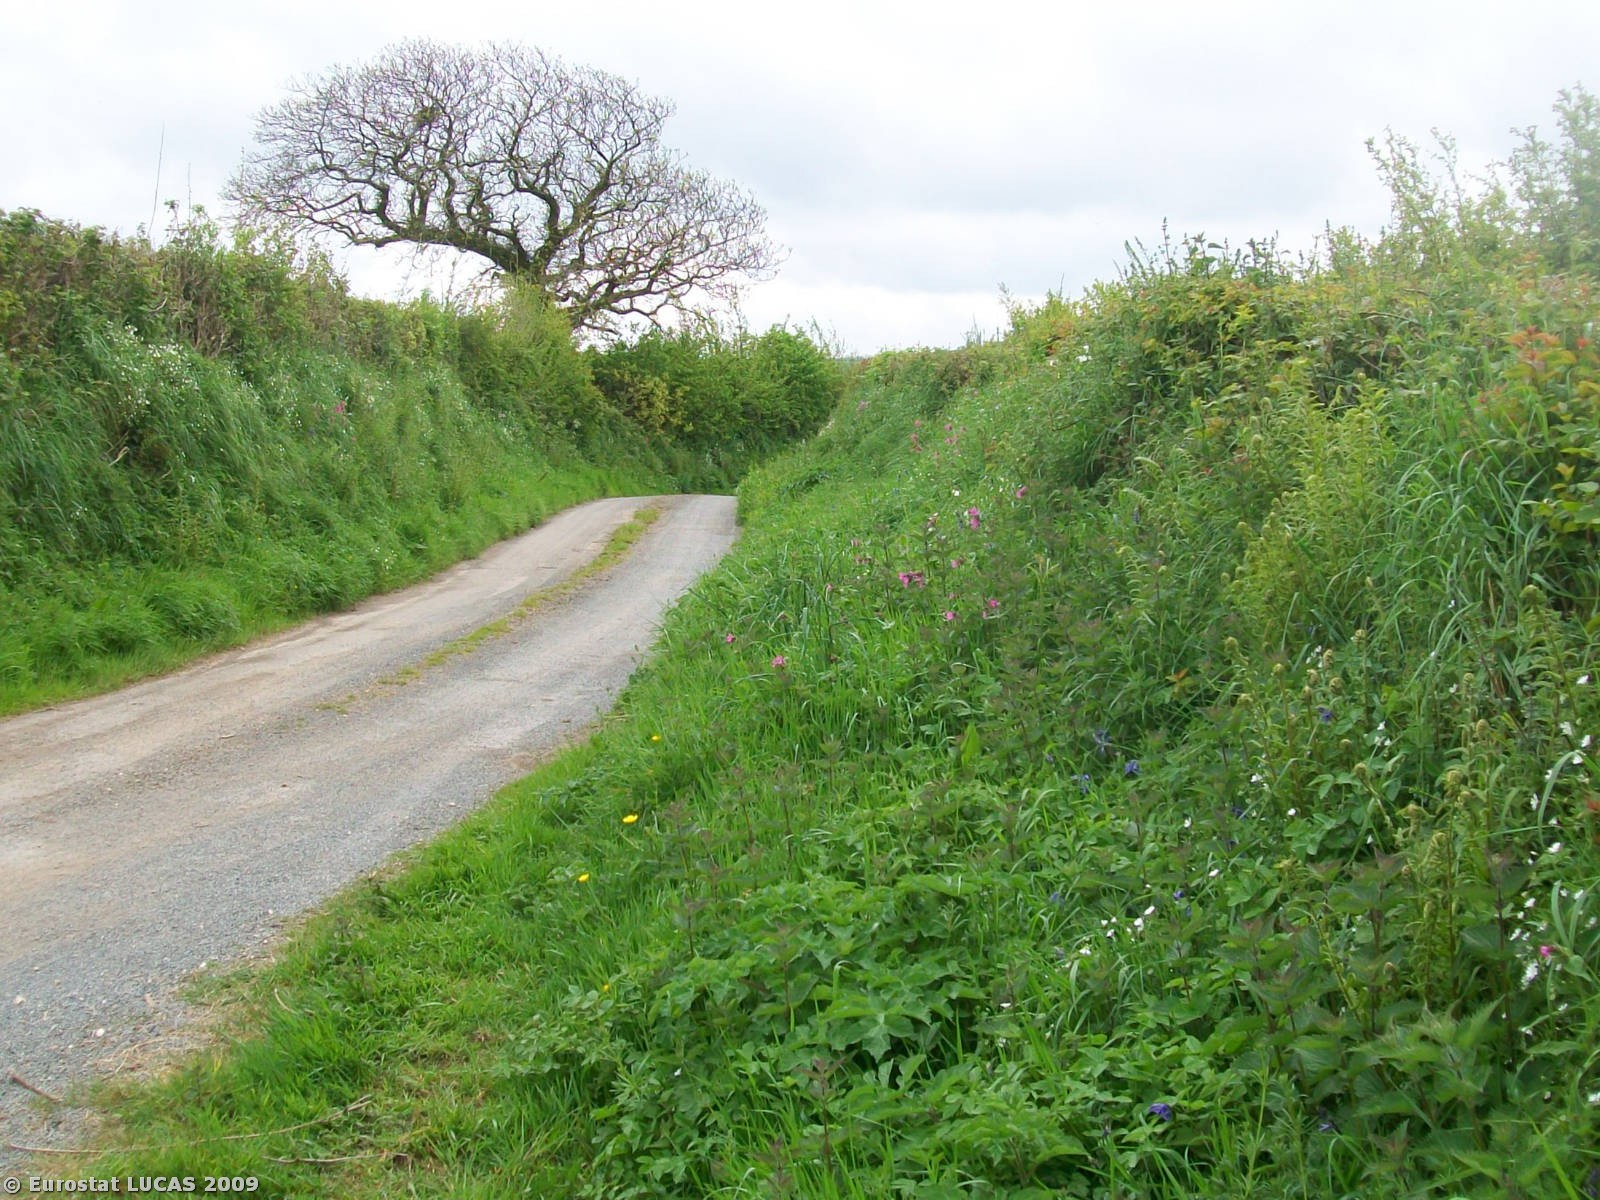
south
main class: Grassland
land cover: Grassland without tree/shrub cover
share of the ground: > 75 %
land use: Agriculture (excluding fallow land and kitchen gardens)
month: May
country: GB
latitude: 50.5117
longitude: -4.3582
